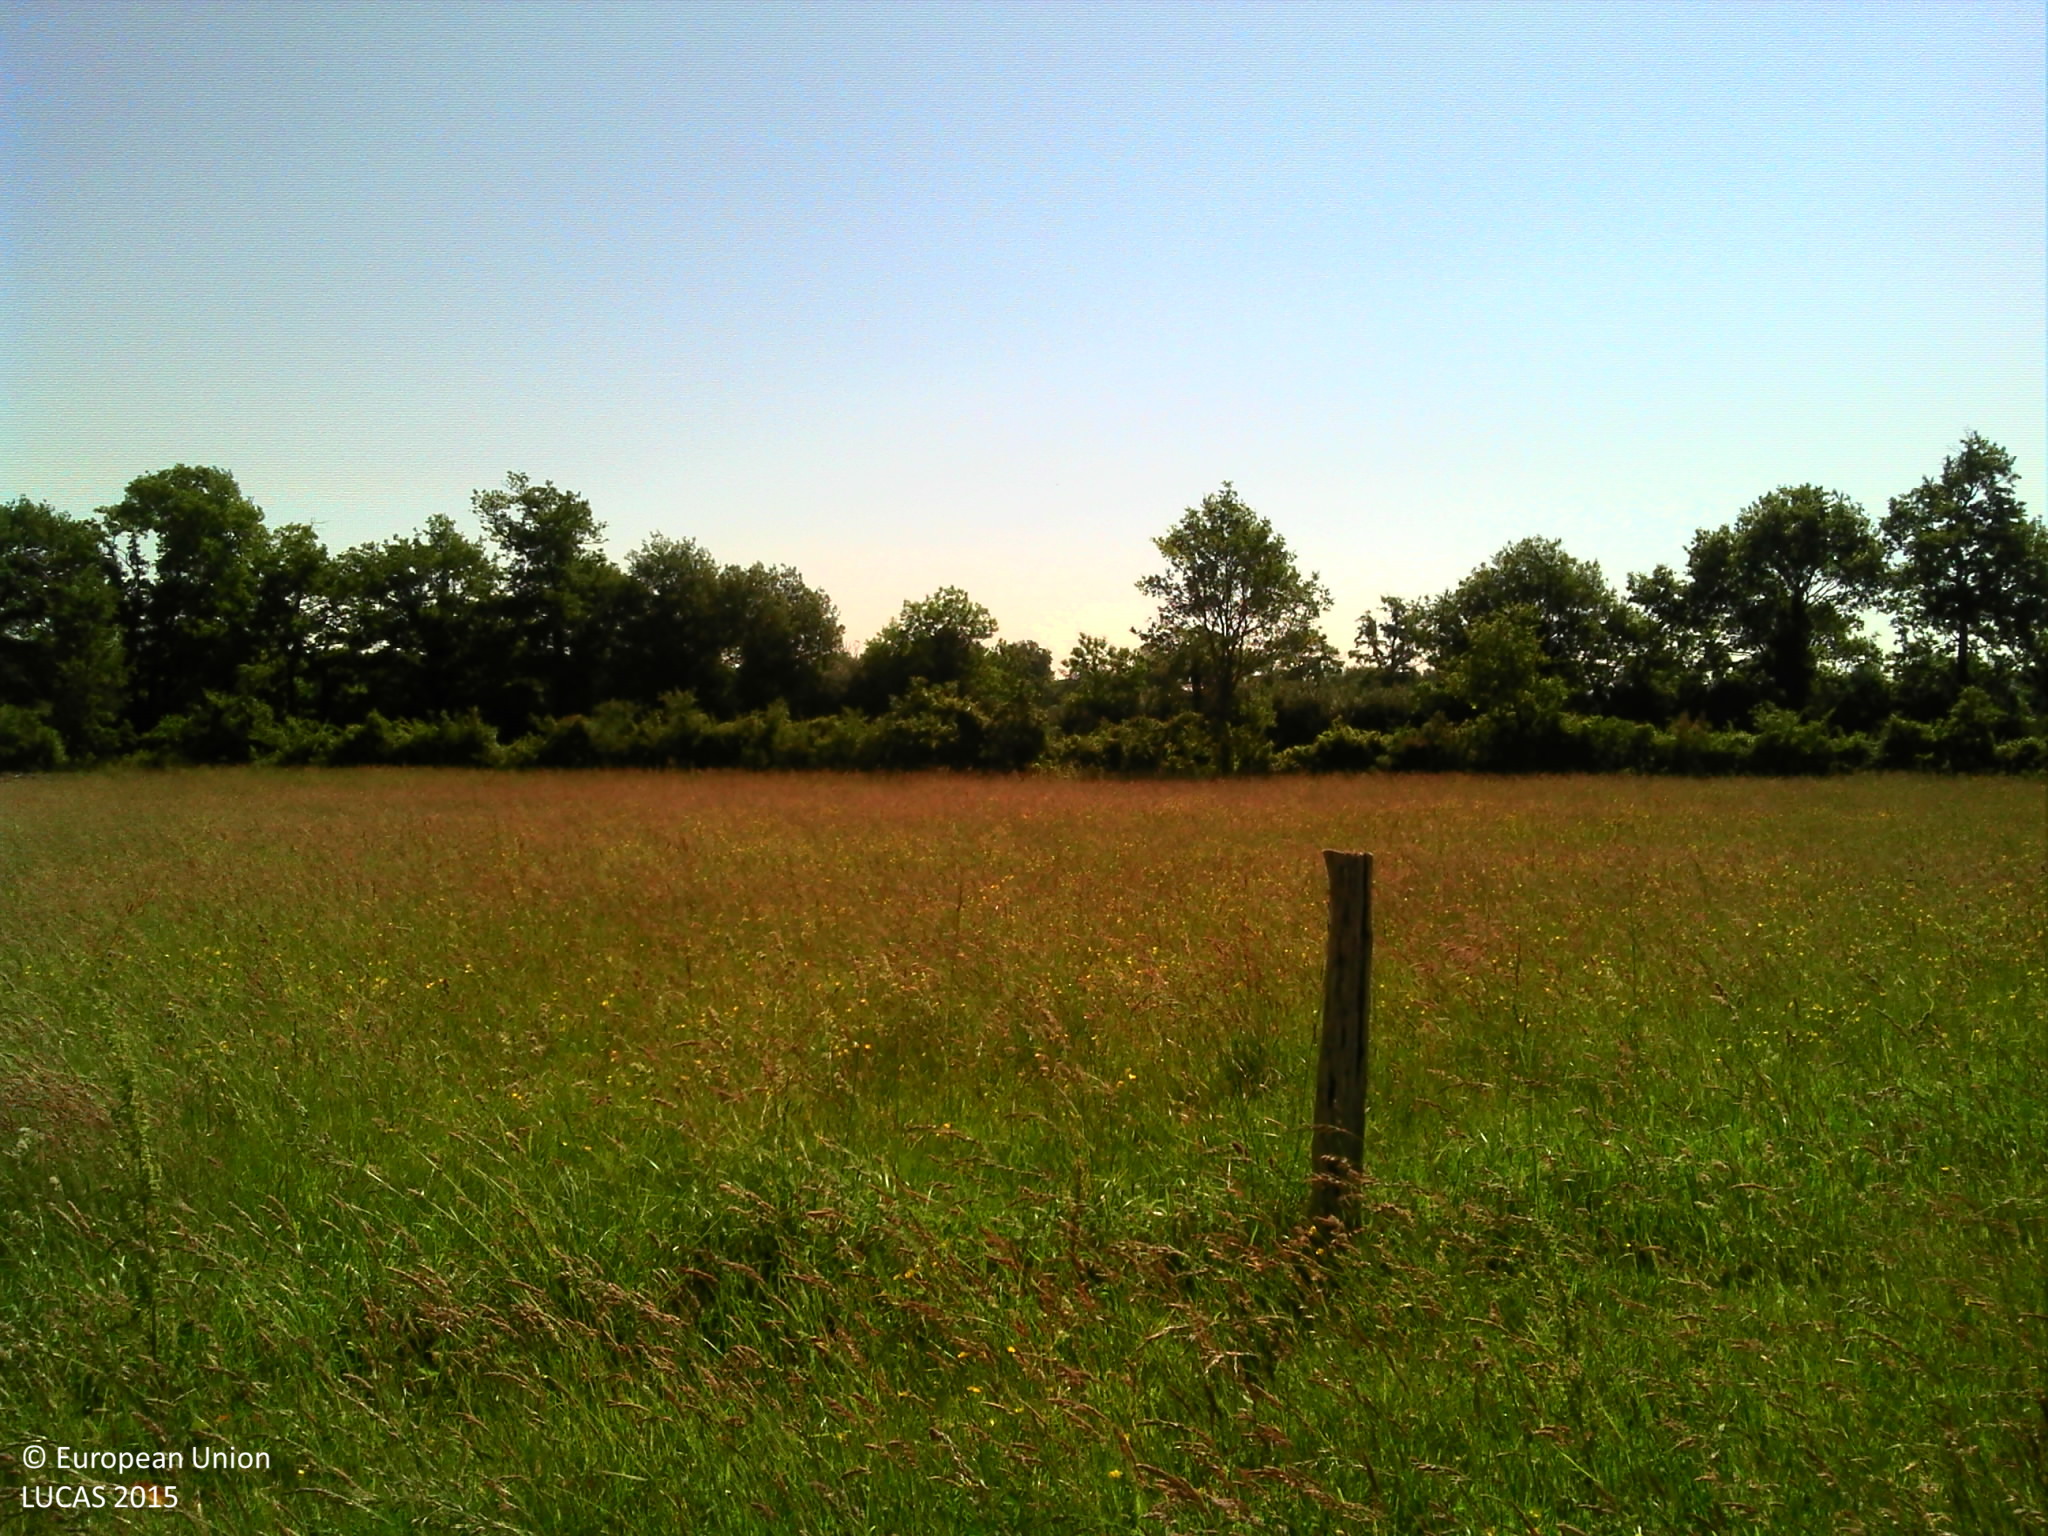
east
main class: Grassland
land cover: Grassland without tree/shrub cover
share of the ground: > 75 %
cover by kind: herbaceous plants 100 %
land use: Agriculture (excluding fallow land and kitchen gardens)
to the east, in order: Grassland without tree/shrub cover; Fences; Grassland without tree/shrub cover; Fences; Managed hedges; Ditches and canals; Grass margins; Tracks; Grassland without tree/shrub cover; Ditches and canals; Managed hedges; Fences; Grassland without tree/shrub cover
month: June
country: FR
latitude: 46.0466
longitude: 0.6160
